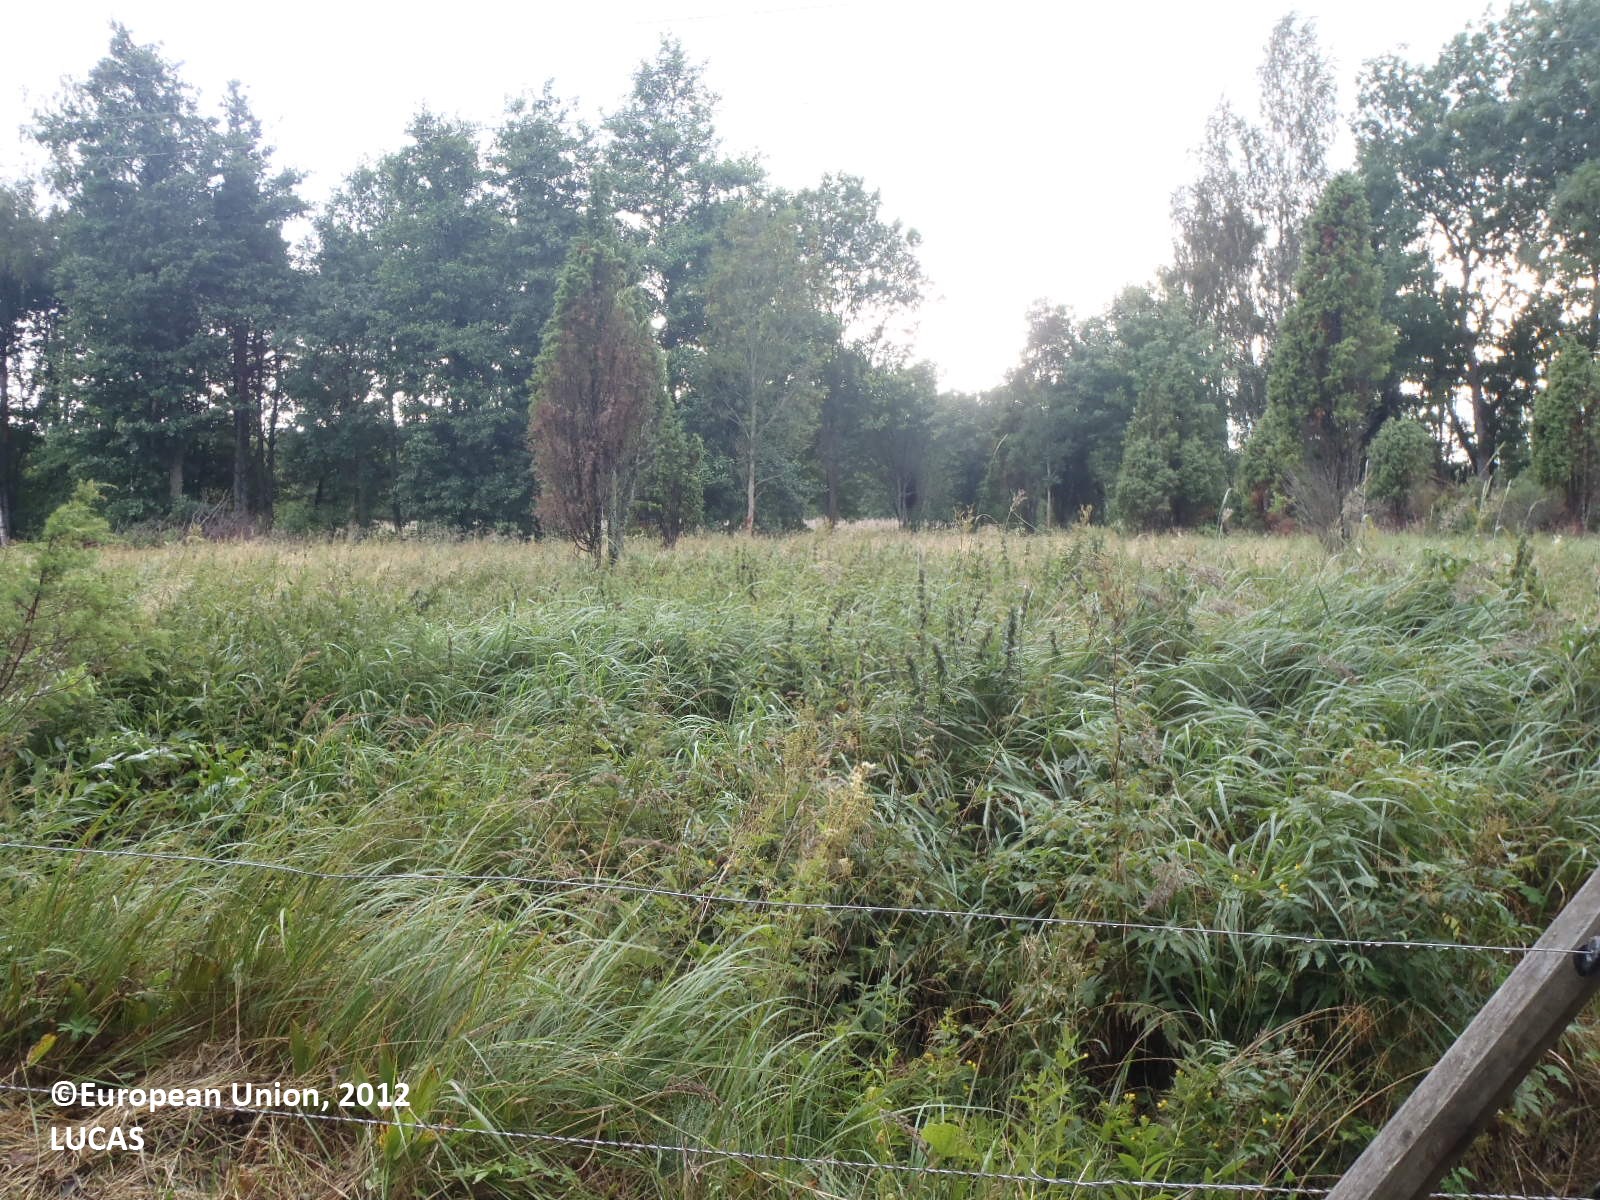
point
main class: Woodland
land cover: Broadleaved woodland
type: hemiboreal forest and nemoral coniferous forest and mixed broadleaved-coniferous forest
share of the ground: > 75 %
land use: Agriculture (excluding fallow land and kitchen gardens)
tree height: > 5 m
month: August
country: FI
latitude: 60.1208
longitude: 19.9223
